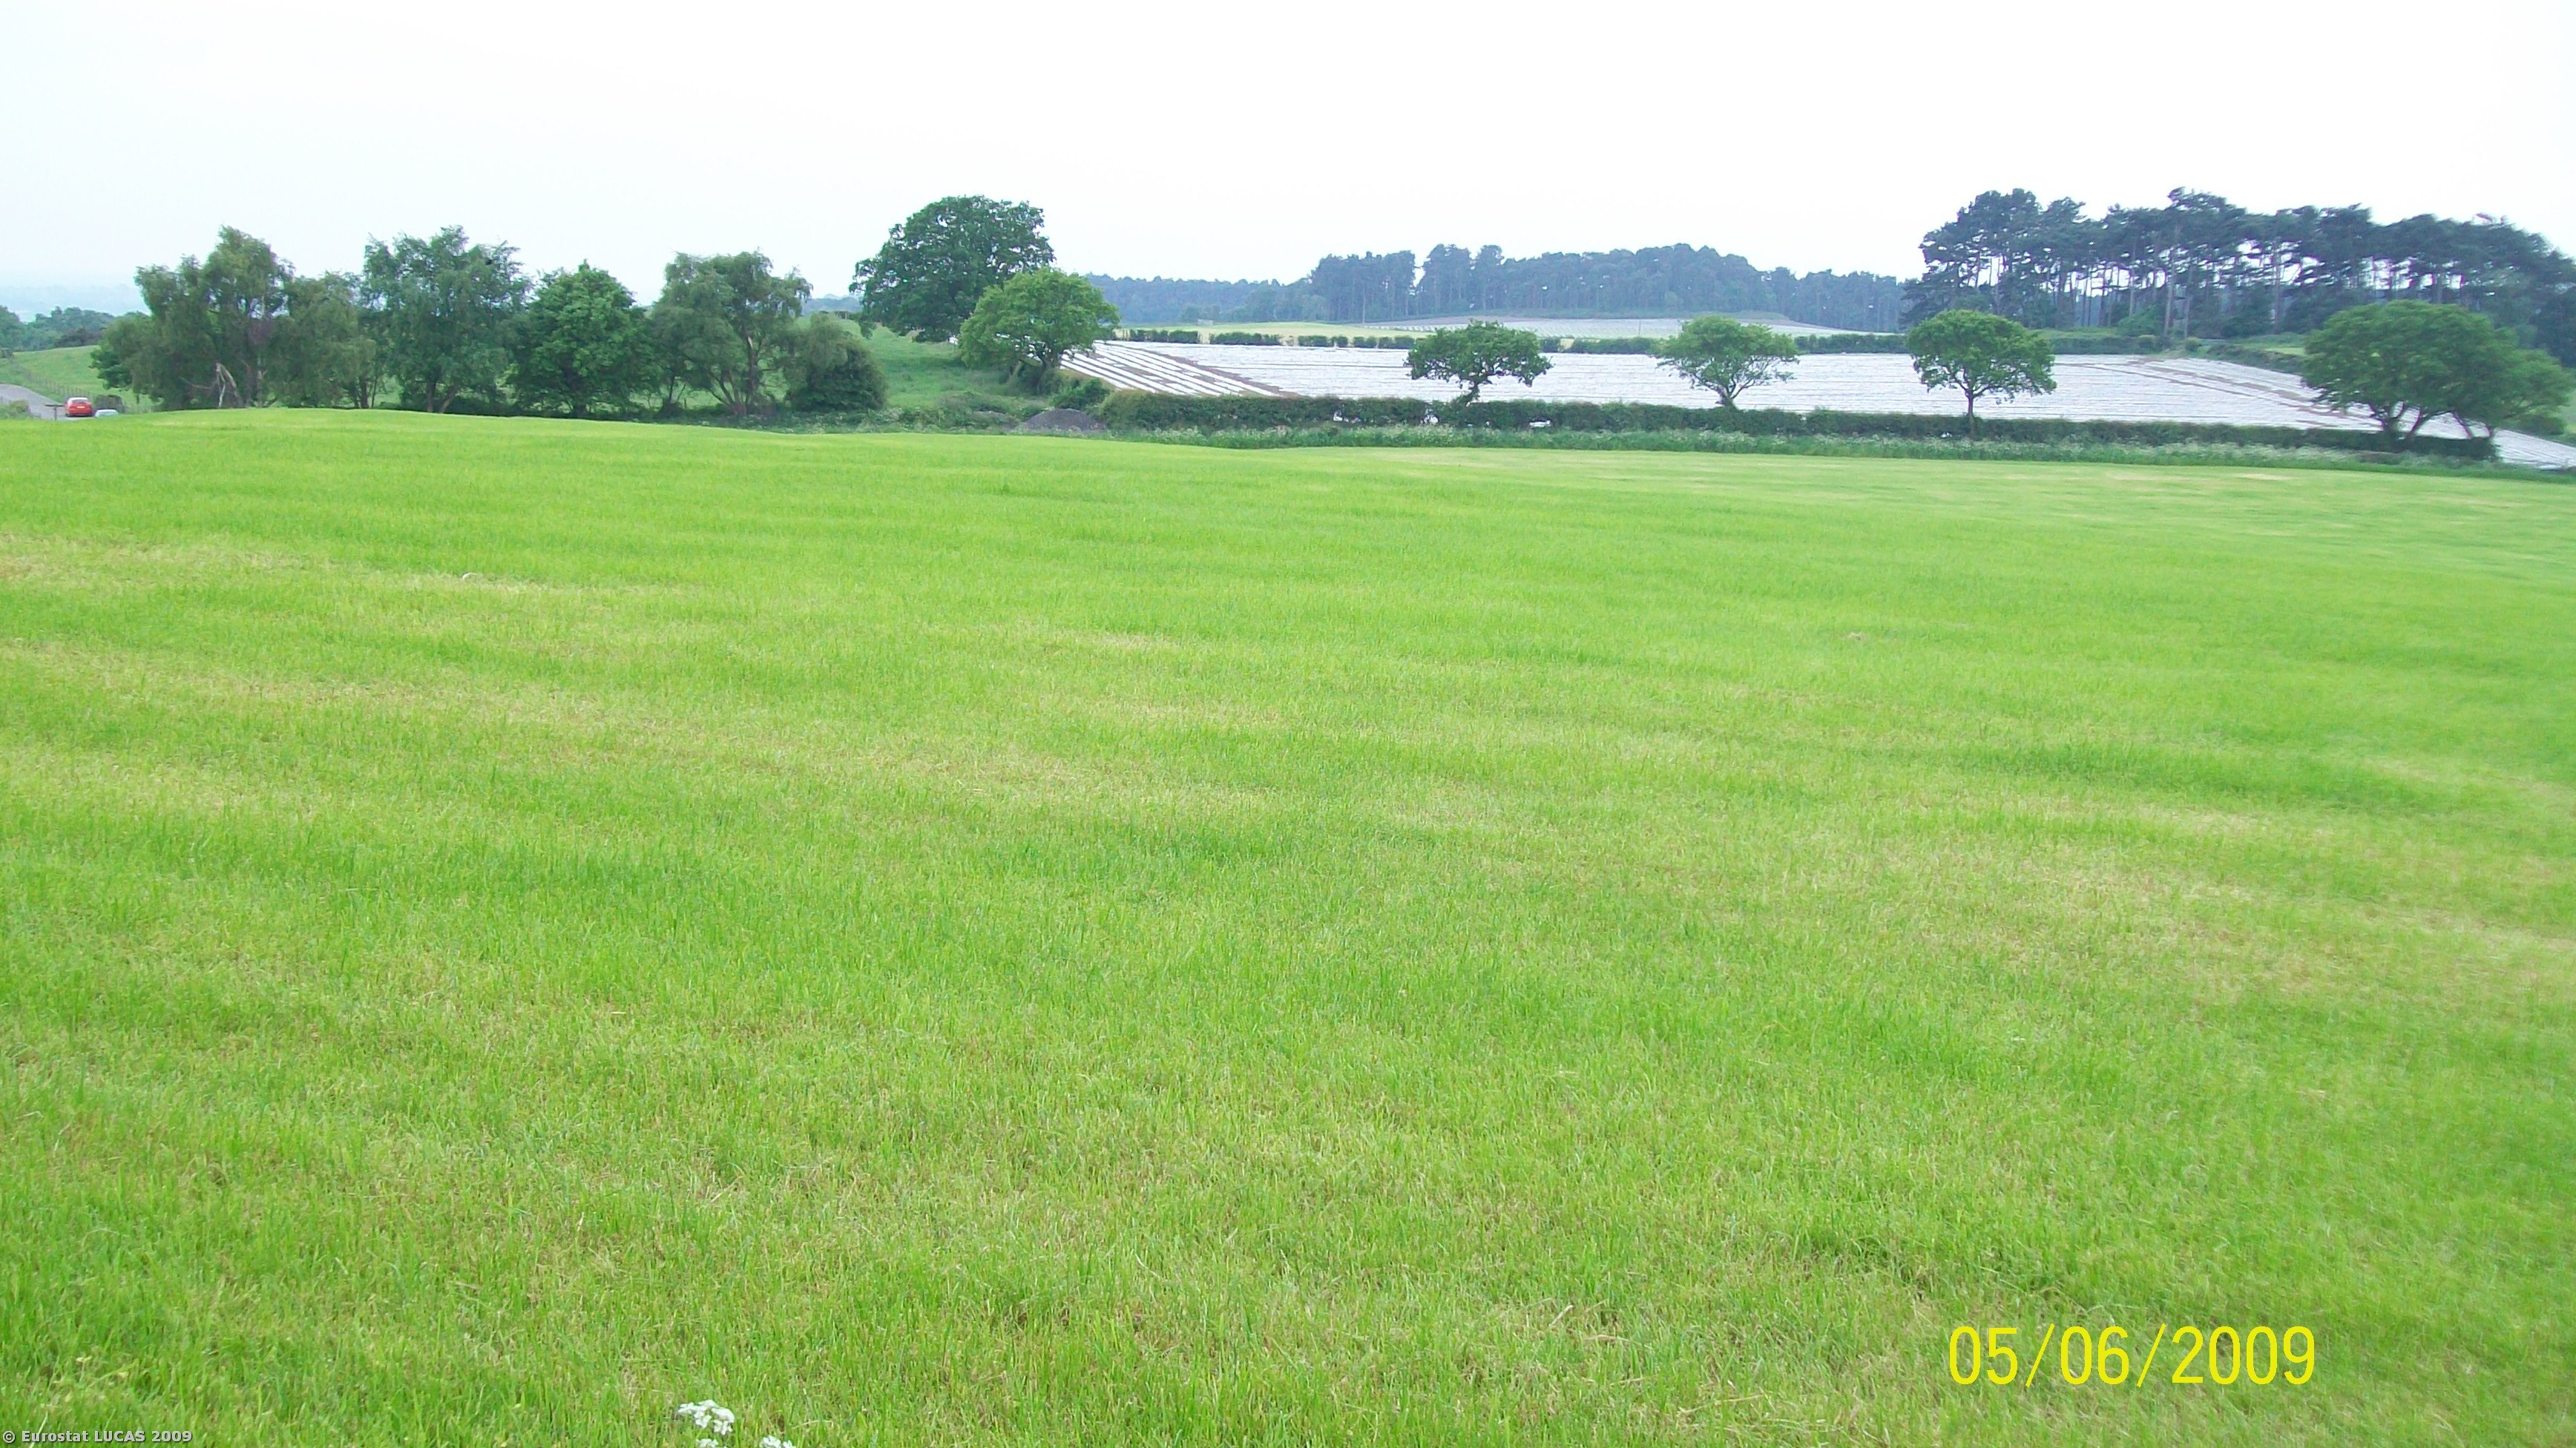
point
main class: Grassland
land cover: Grassland without tree/shrub cover
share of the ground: > 75 %
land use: Agriculture (excluding fallow land and kitchen gardens)
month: June
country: GB
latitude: 53.0922
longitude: -2.7174
